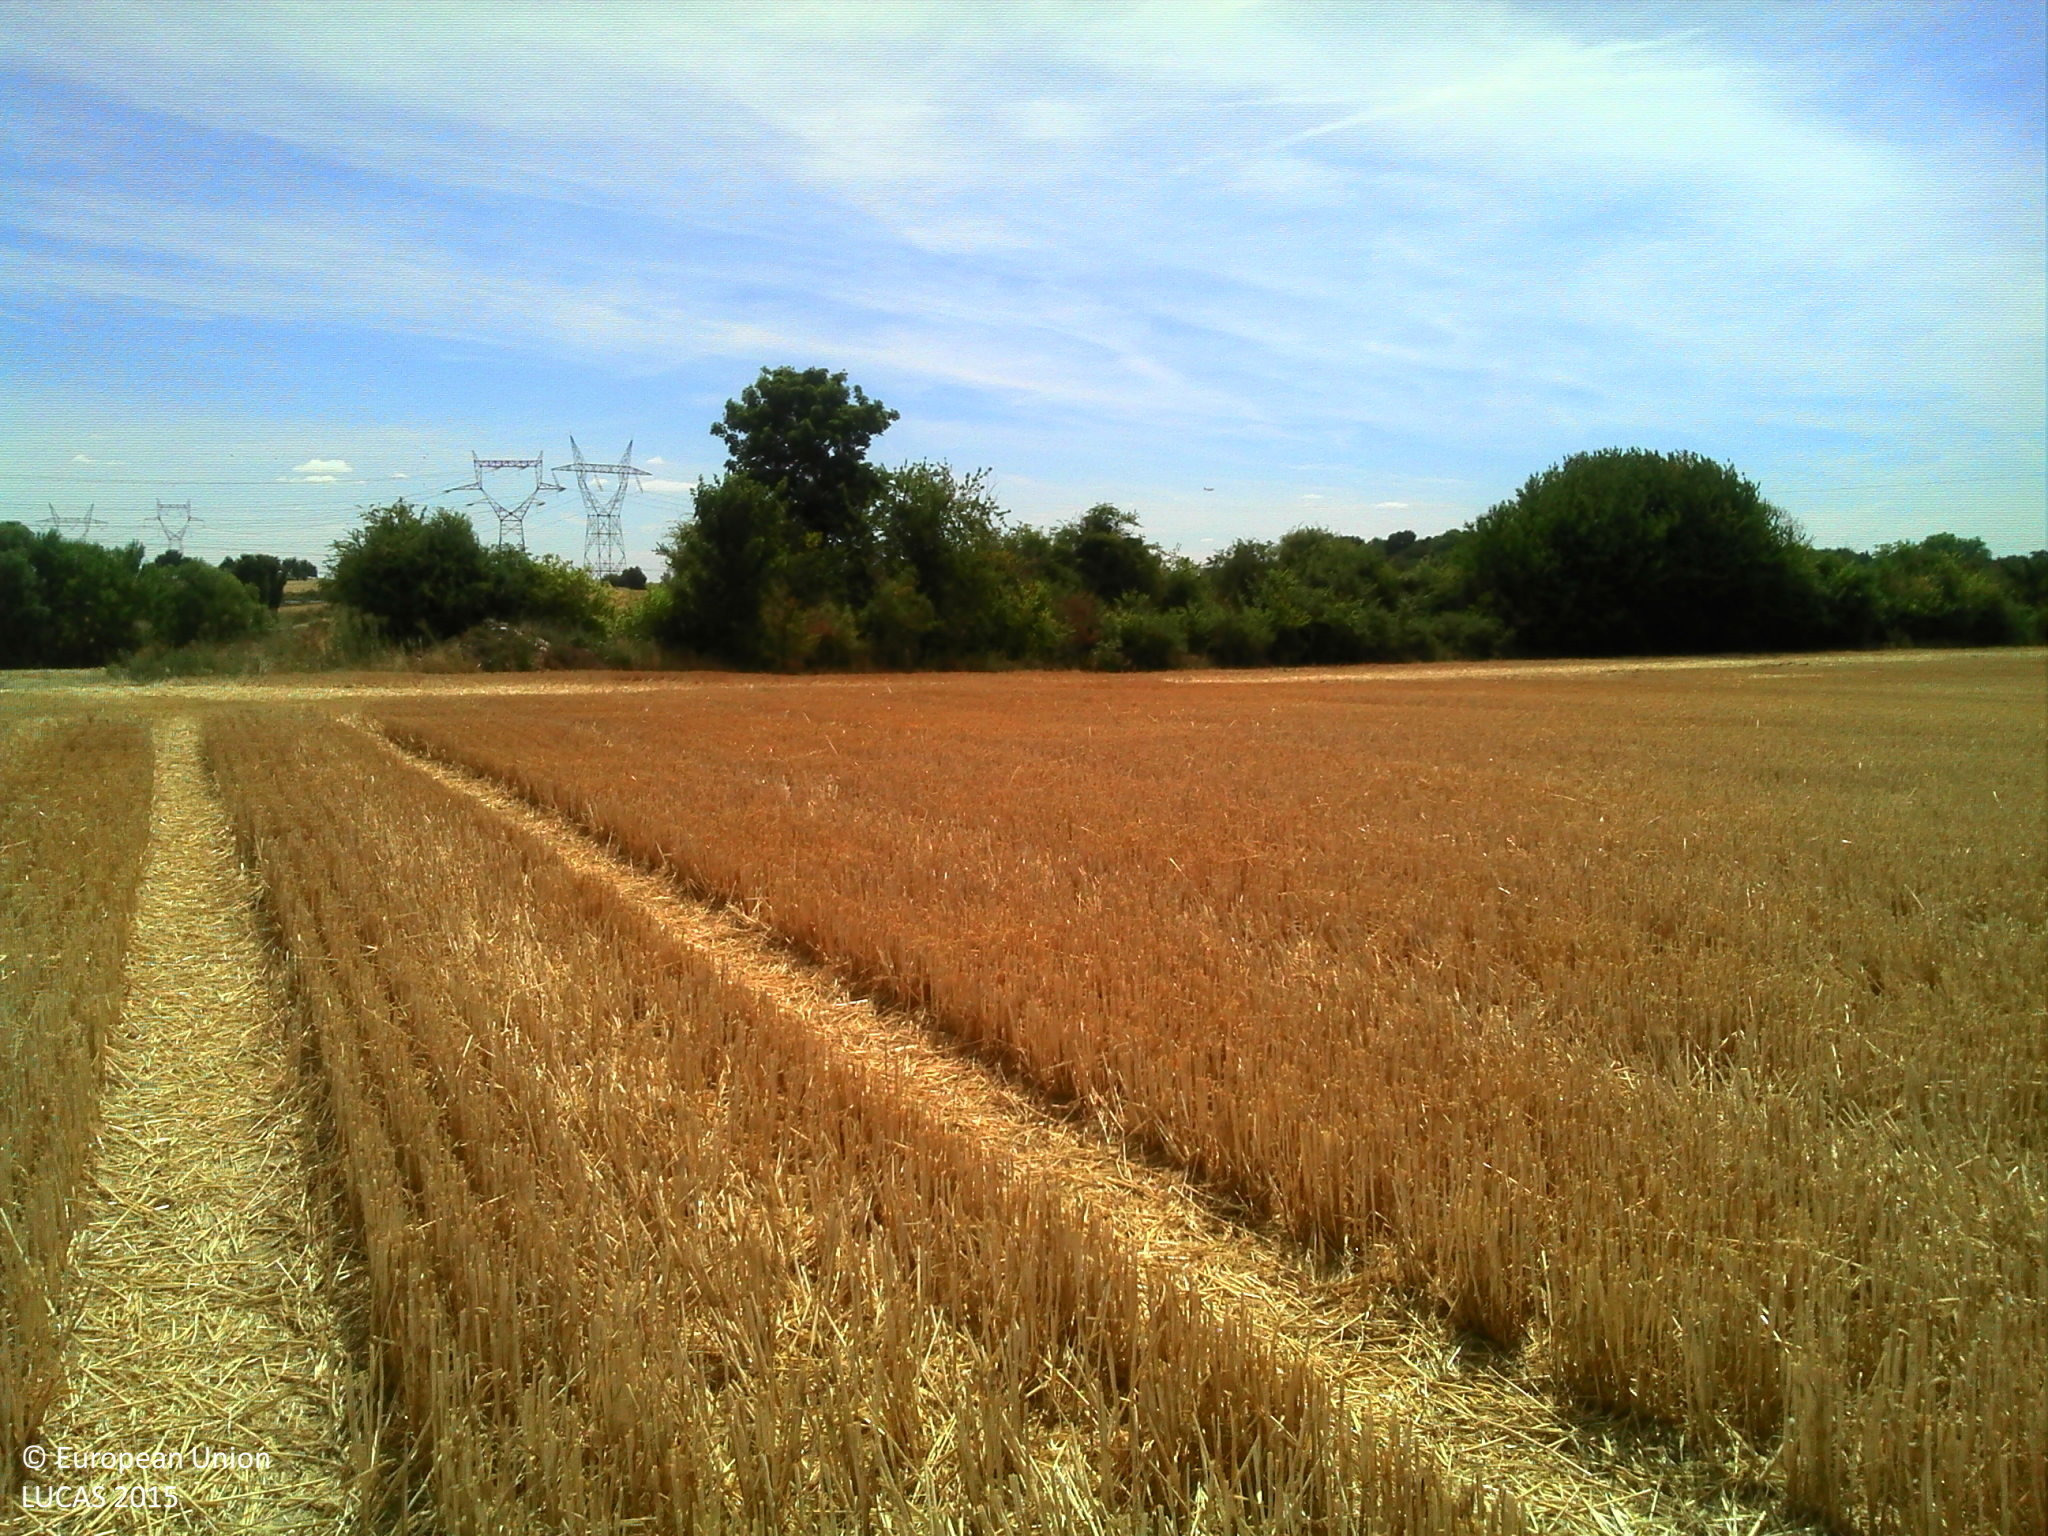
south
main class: Cropland
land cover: Common wheat
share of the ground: > 75 %
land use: Agriculture (excluding fallow land and kitchen gardens)
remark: Harvested field
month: August
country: FR
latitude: 49.0434
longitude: 2.6427
